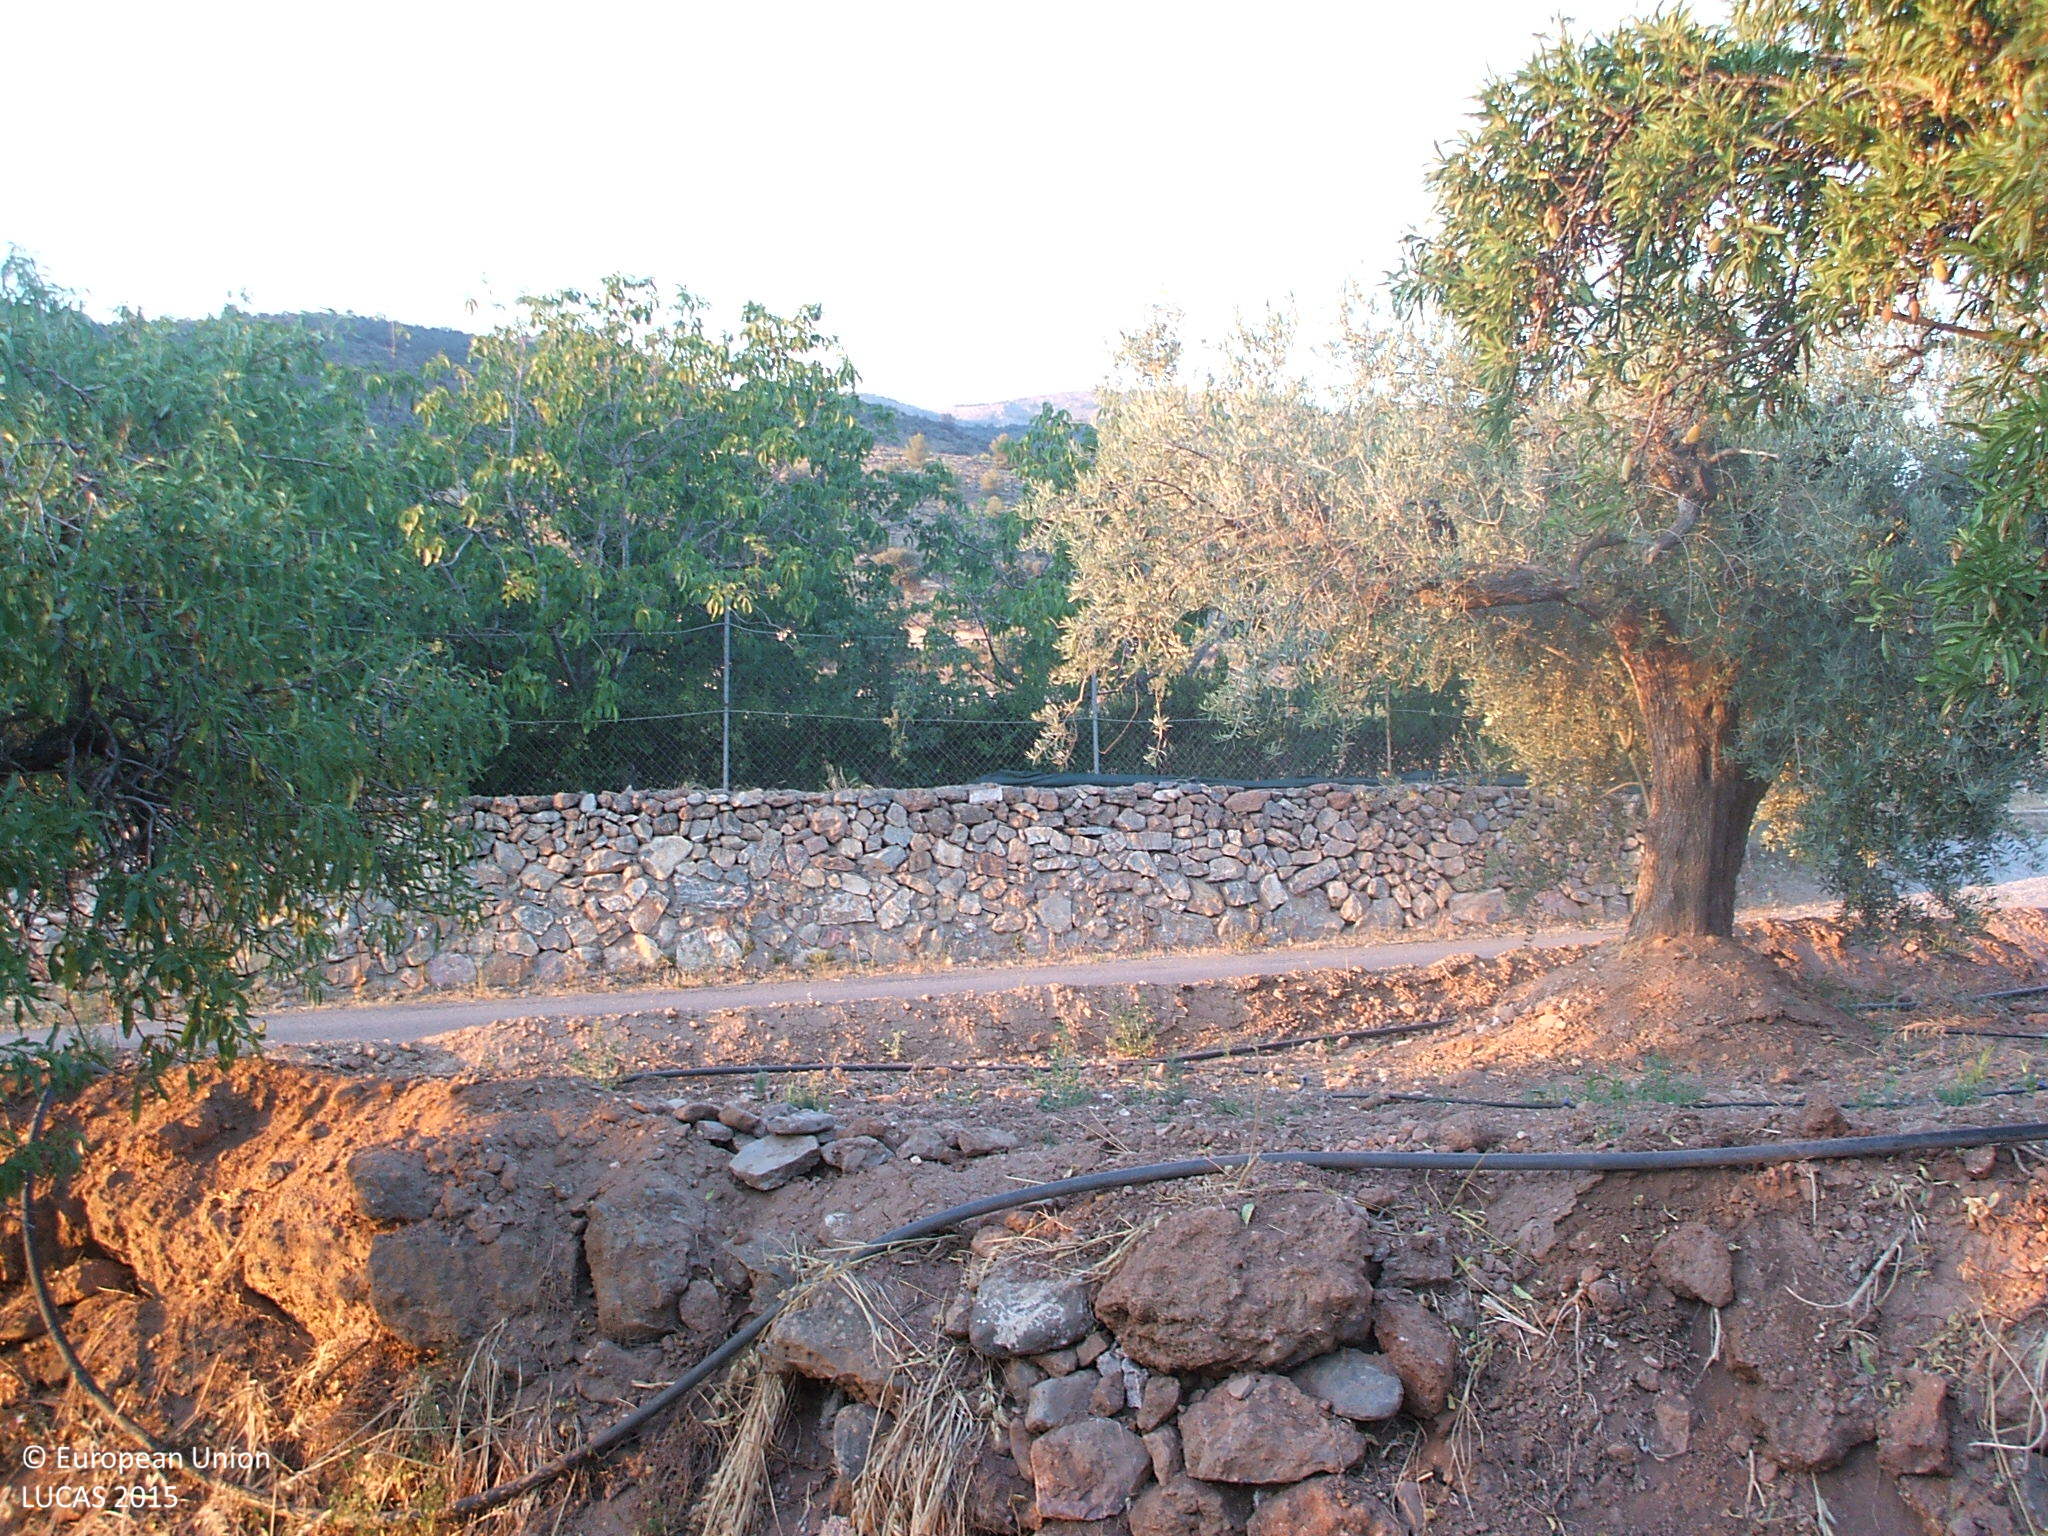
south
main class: Cropland
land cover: Olive groves
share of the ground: 25 - 50 %
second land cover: Other bare soil
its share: > 75 %
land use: Agriculture (excluding fallow land and kitchen gardens)
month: July
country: ES
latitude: 36.9797
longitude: -2.8654
